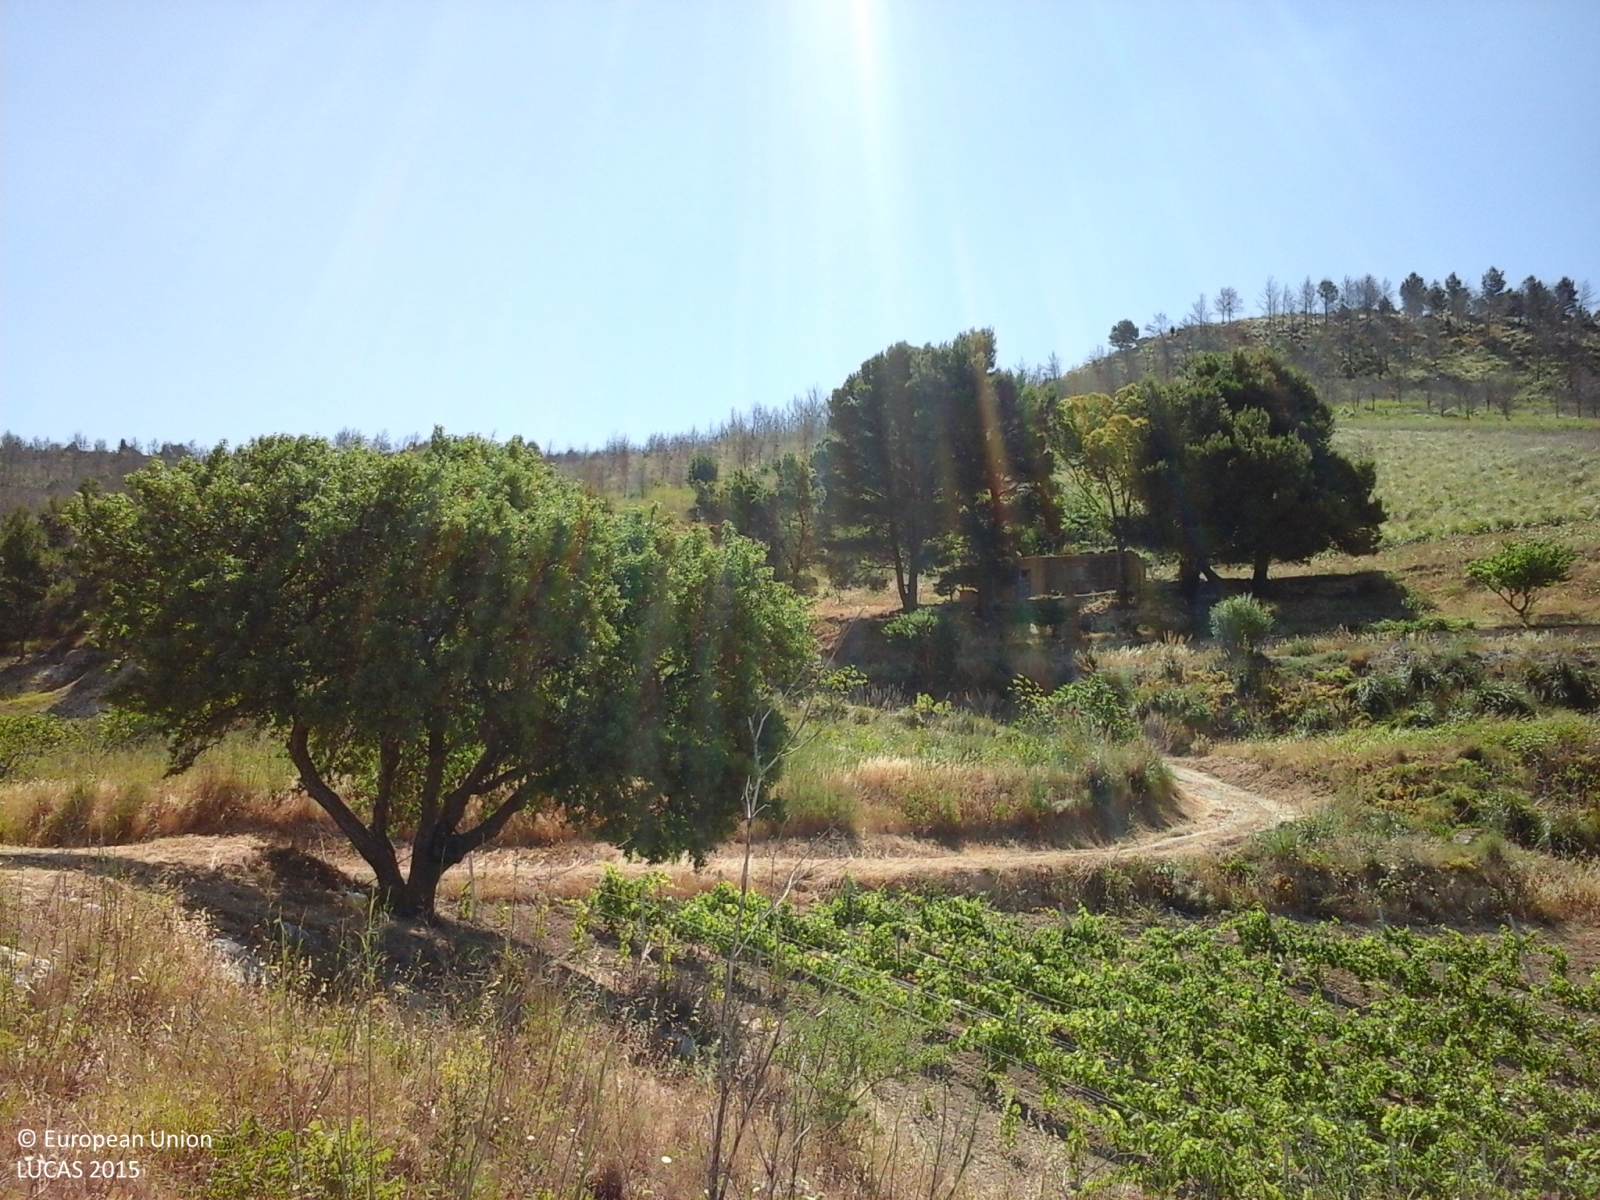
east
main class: Grassland
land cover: Grassland without tree/shrub cover
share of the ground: > 75 %
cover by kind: herbaceous plants 90 %, unconsolidated bare surface 10 %
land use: Agriculture (excluding fallow land and kitchen gardens)
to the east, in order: Grassland without tree/shrub cover; Vineyards; Grass margins; Tracks; Grass margins; Vineyards; Grass margins; Paved roads, cycling and walking lanes; Electric lines; Pine dominated coniferous woodland
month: June
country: IT
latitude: 37.7915
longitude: 12.9872
